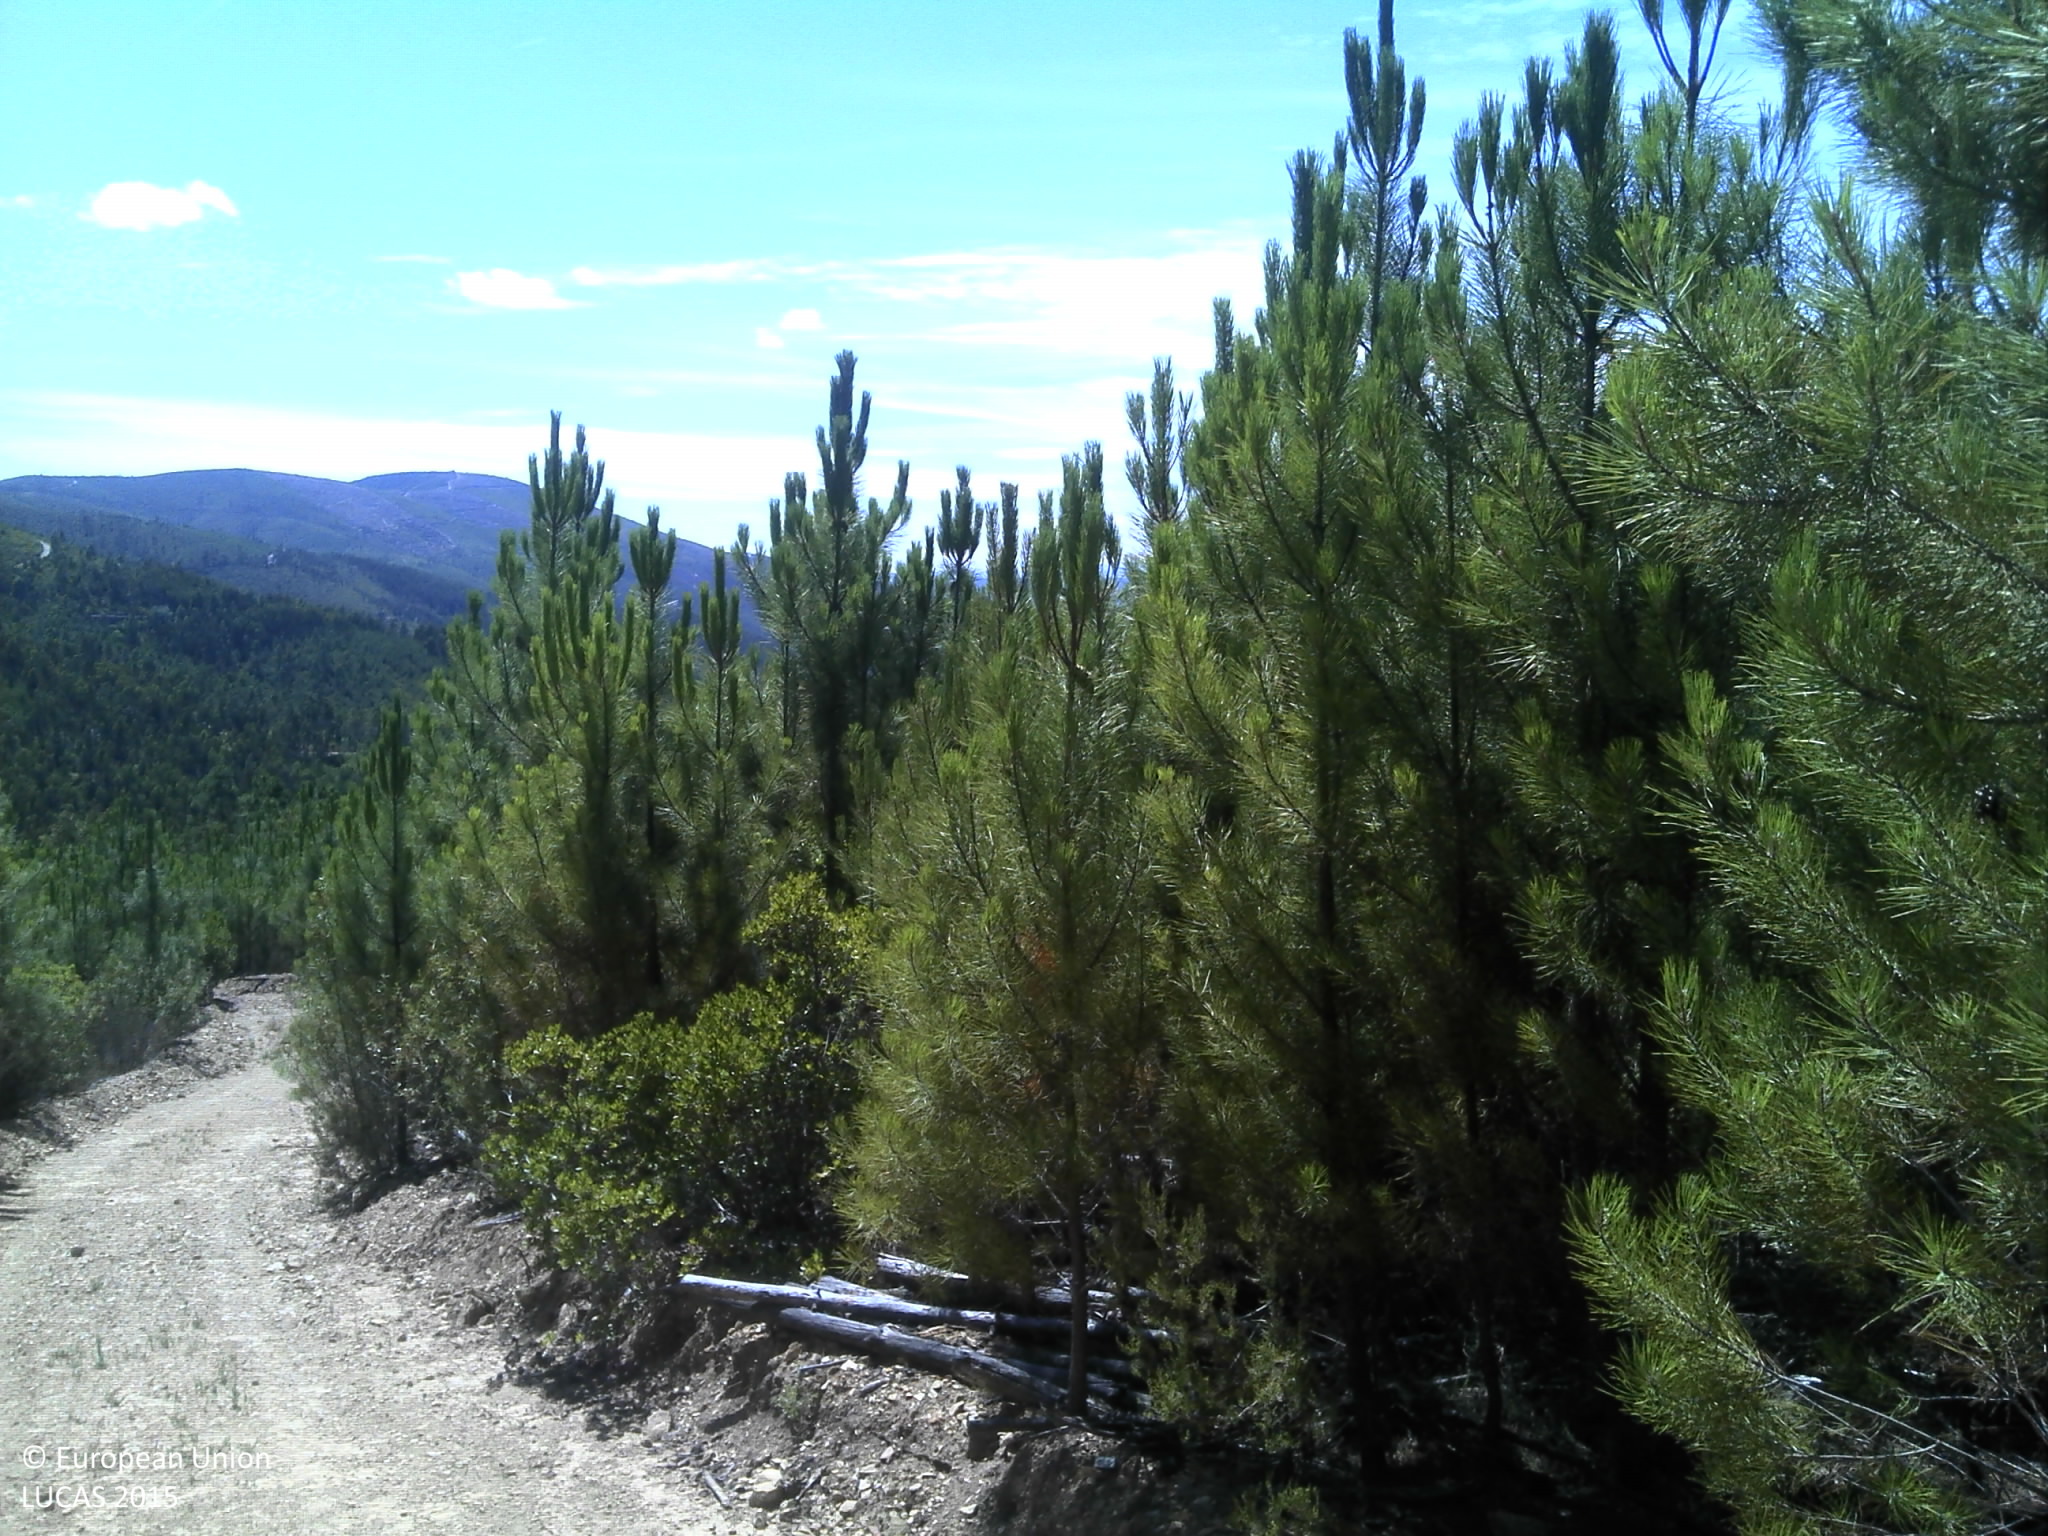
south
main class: Woodland
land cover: Pine dominated coniferous woodland
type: coniferous forest of the mediterranean region
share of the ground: 50 - 75 %
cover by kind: coniferous forest trees 70 %, shrubs 25 %
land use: Forestry
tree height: > 5 m
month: July
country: PT
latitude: 40.0480
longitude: -7.8947
